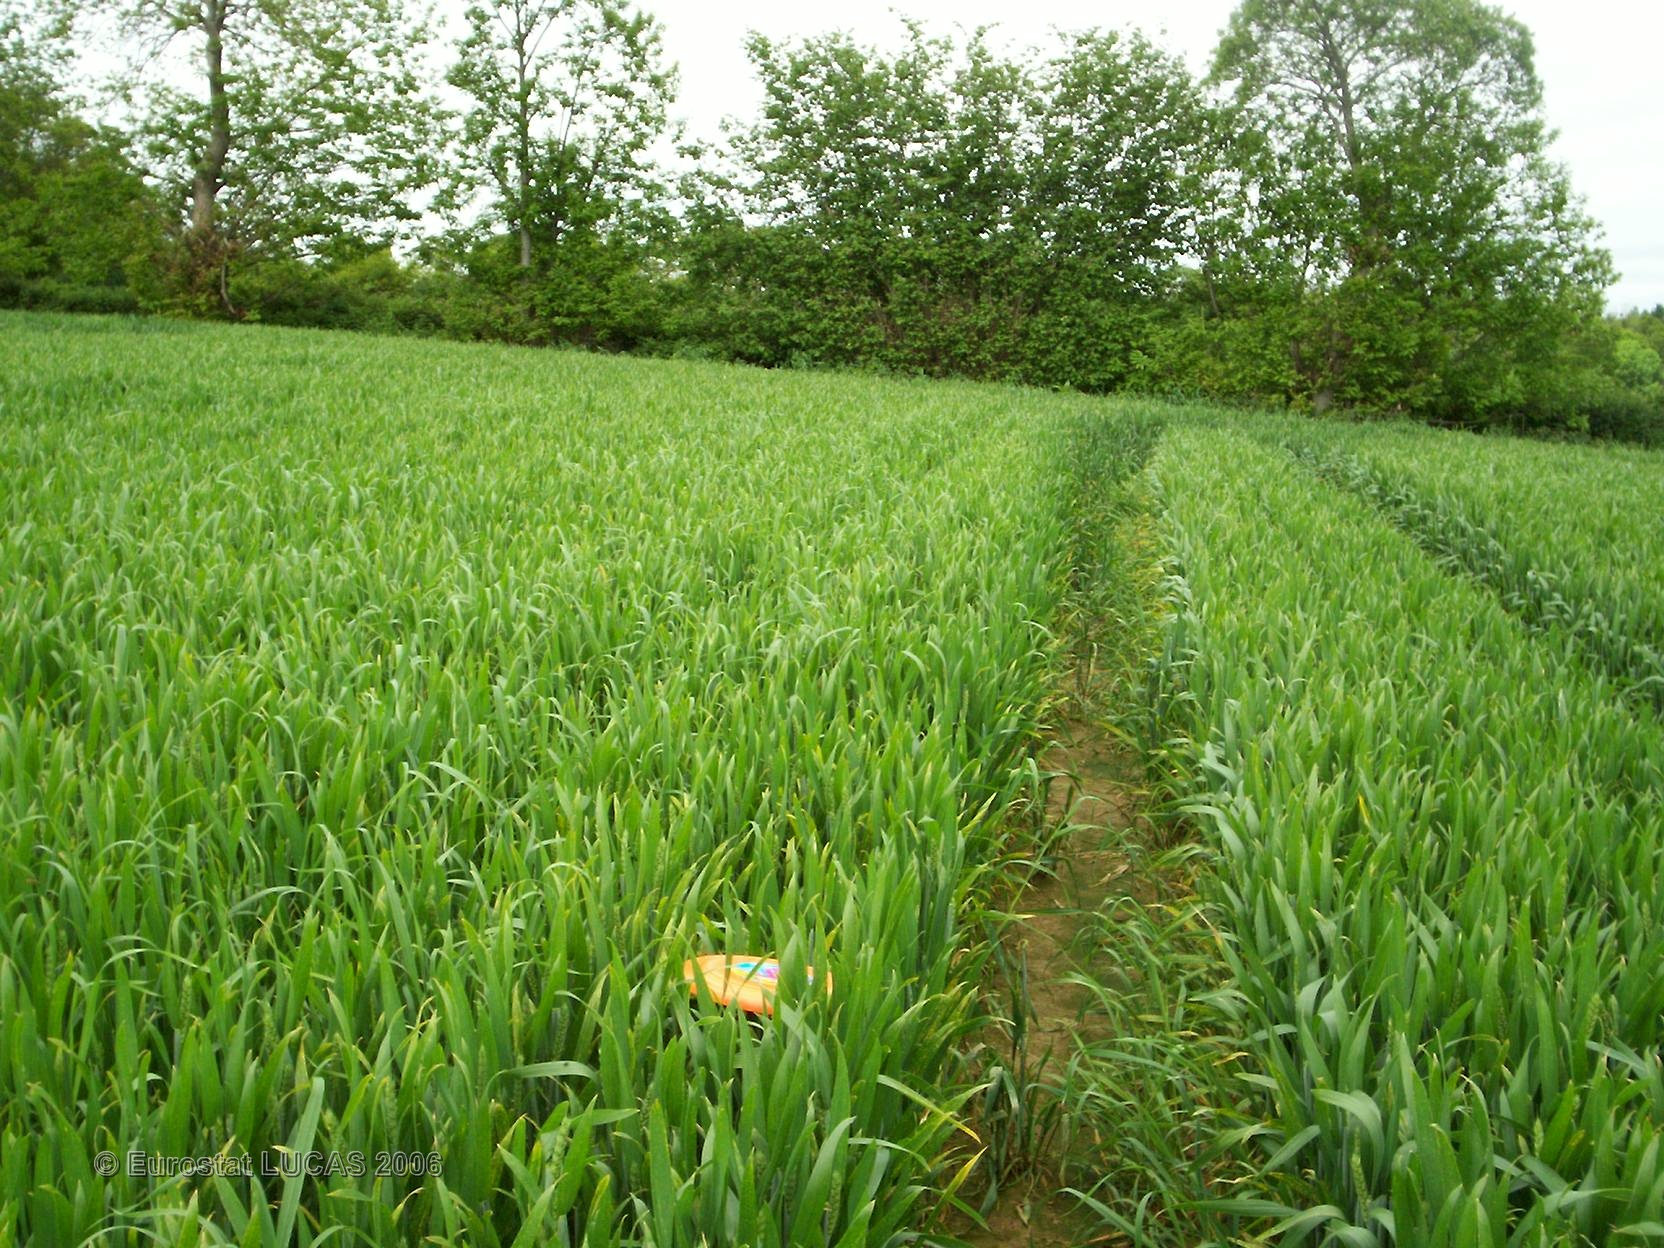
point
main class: Cropland
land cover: Common wheat
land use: Agriculture (excluding fallow land and kitchen gardens)
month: May
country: FR
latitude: 48.6309
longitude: -3.0291
